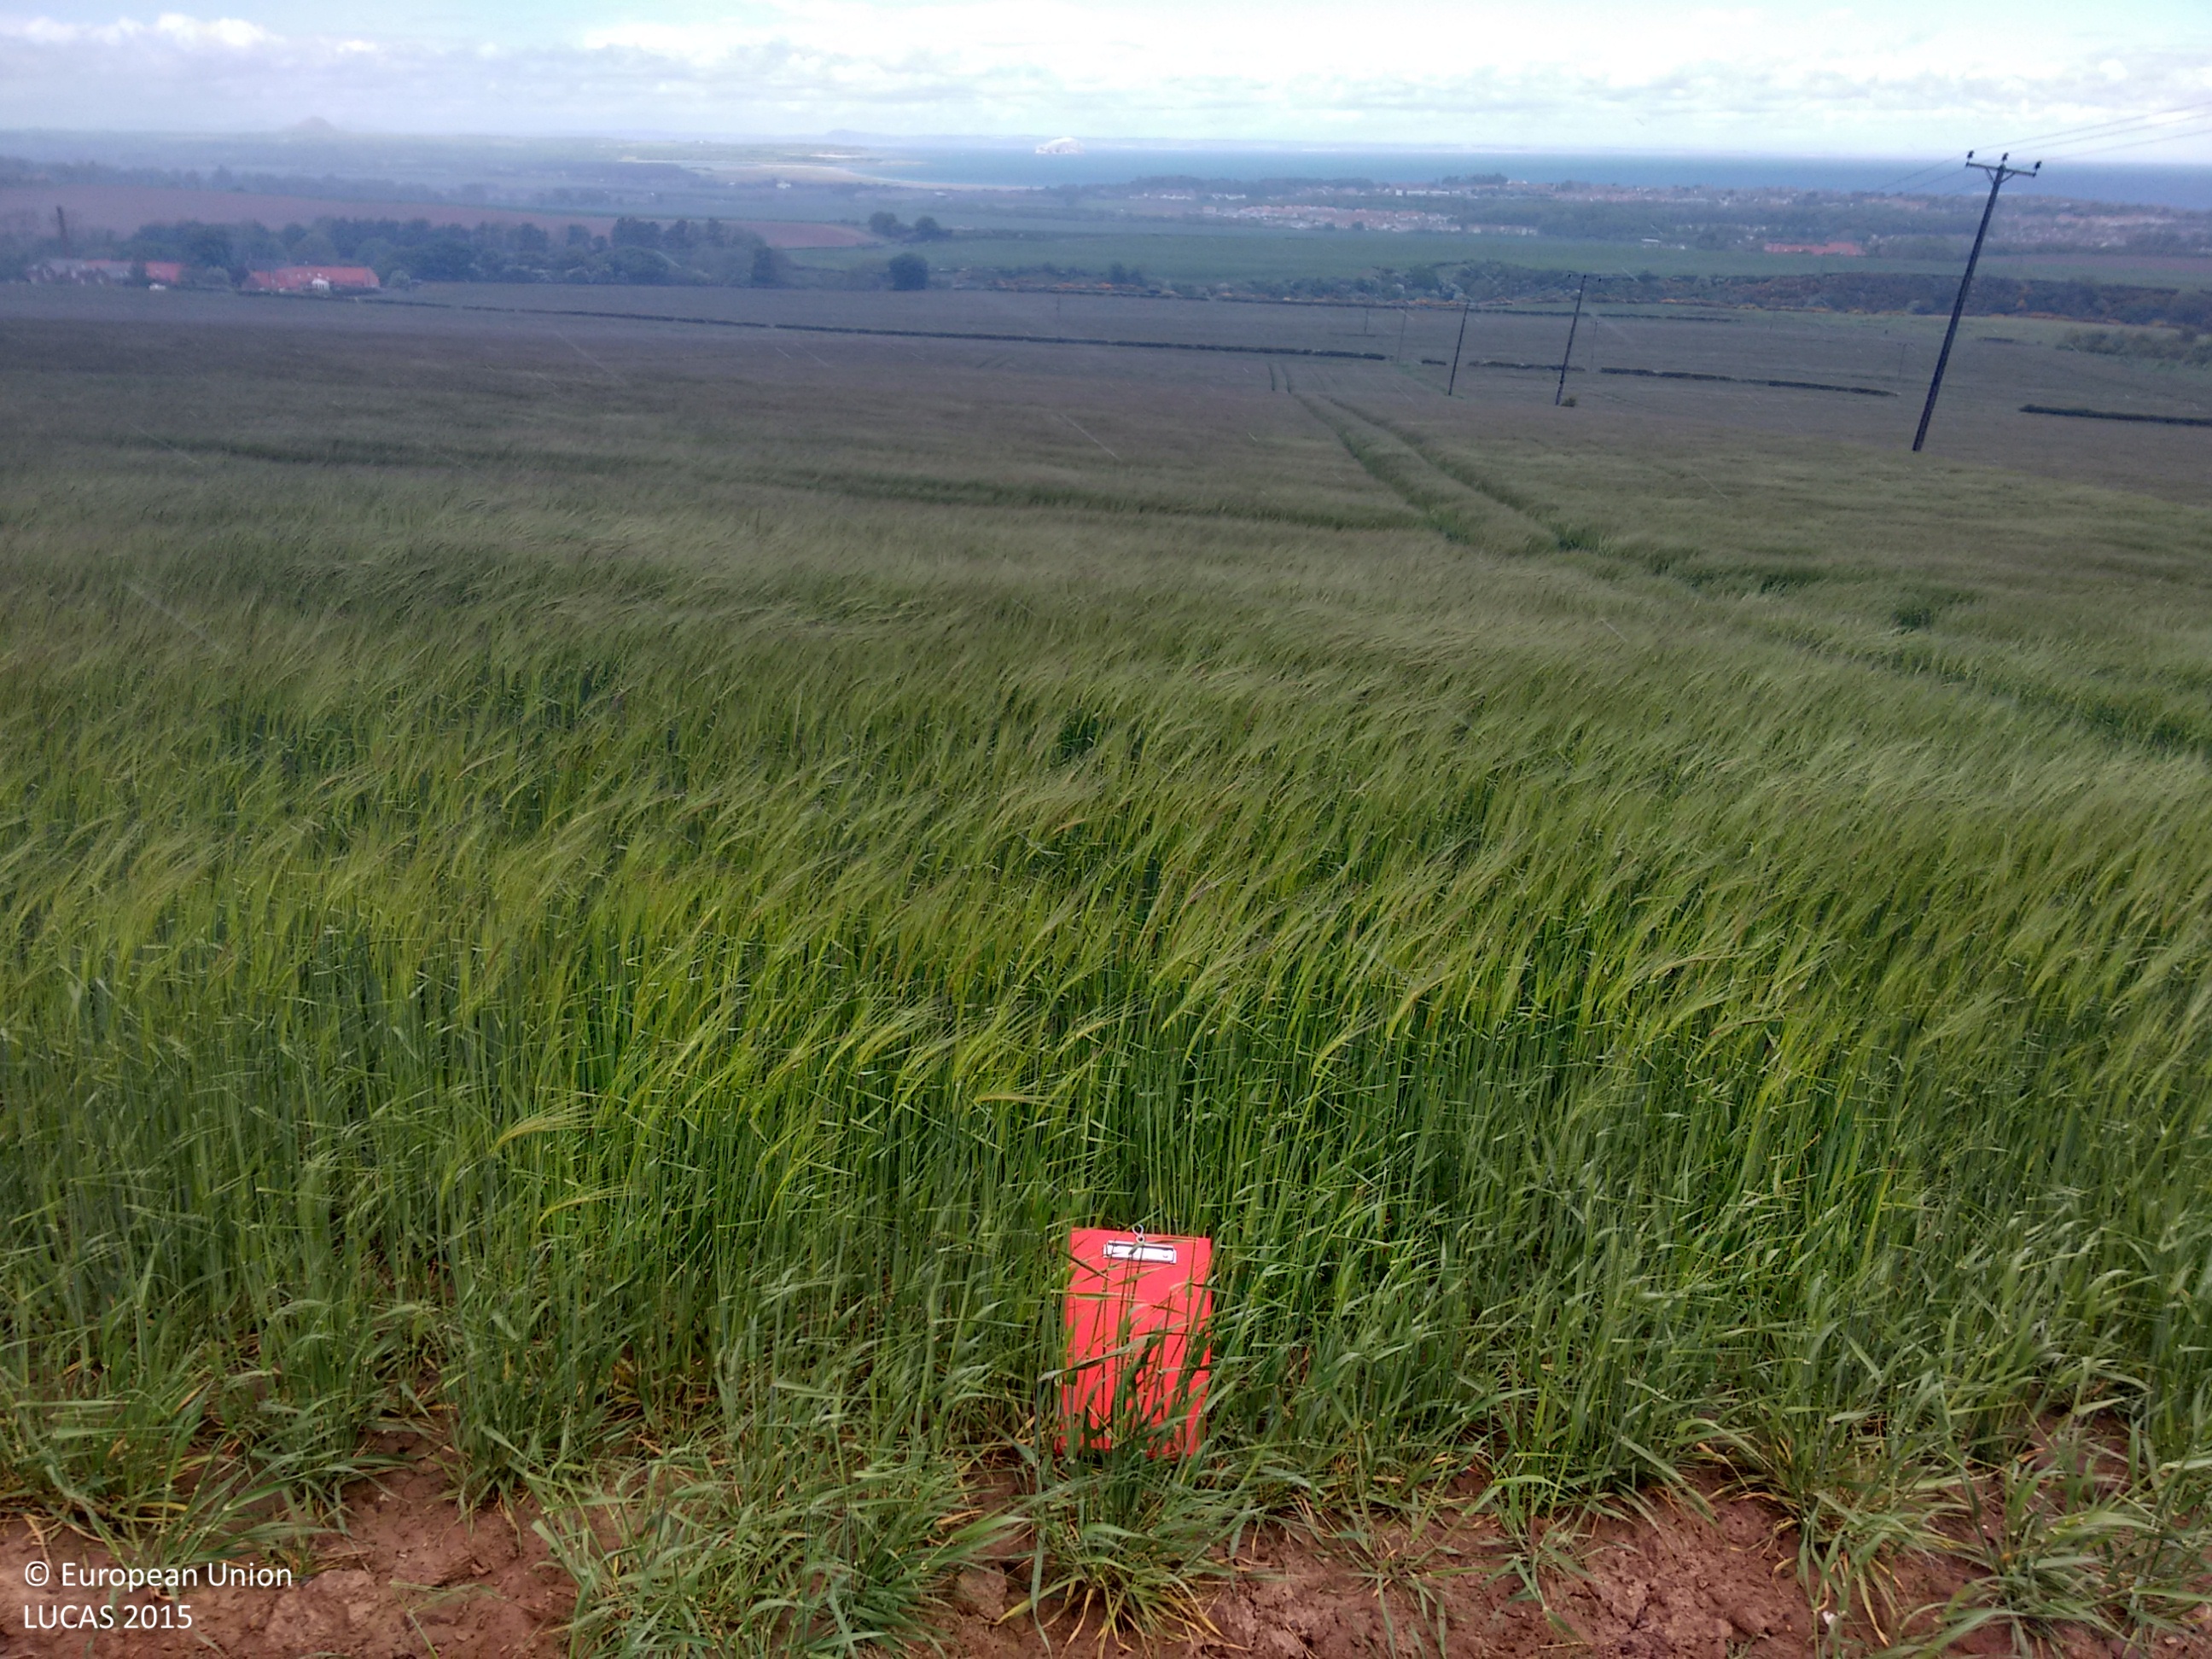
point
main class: Cropland
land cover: Barley
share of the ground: > 75 %
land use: Agriculture (excluding fallow land and kitchen gardens)
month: May
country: GB
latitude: 55.9734
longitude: -2.5099
